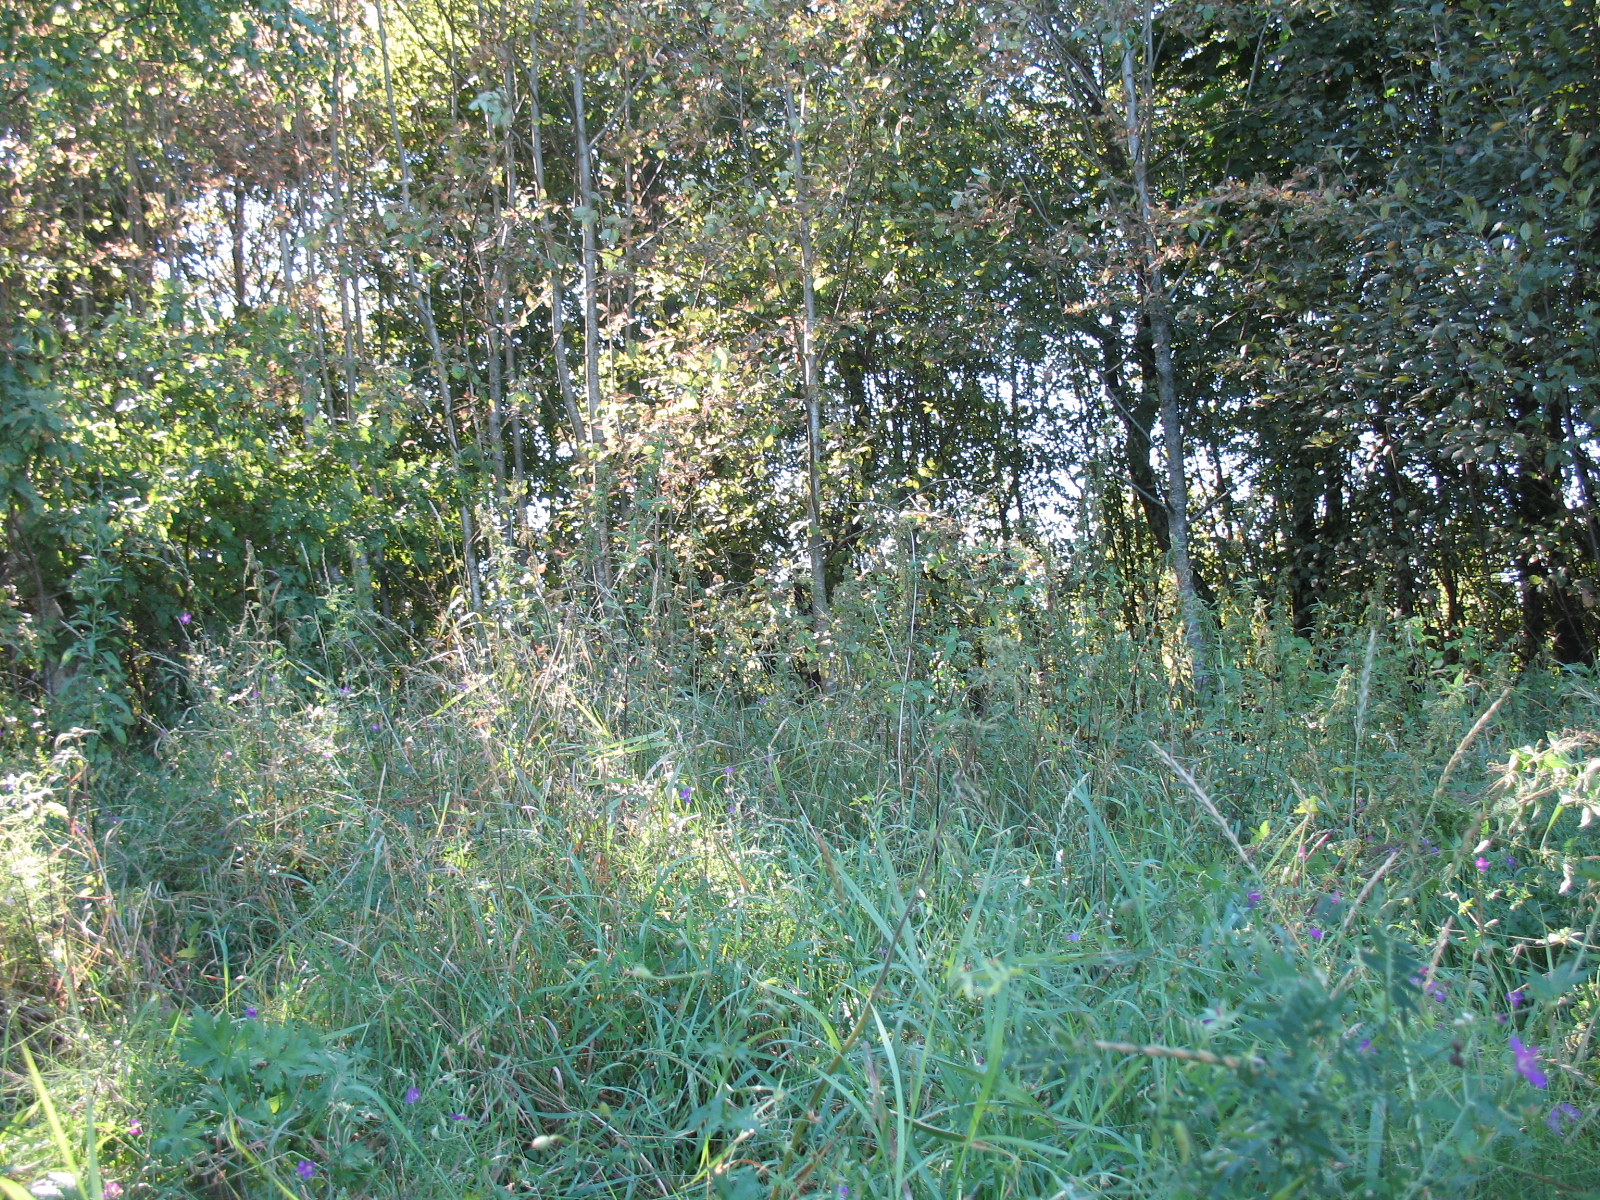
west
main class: Grassland
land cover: Spontaneously vegetated surfaces
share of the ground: > 75 %
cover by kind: herbaceous plants 95 %, shrubs 5 %
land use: Semi-natural and natural areas not in use
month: August
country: LV
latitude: 56.5051
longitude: 25.6402
